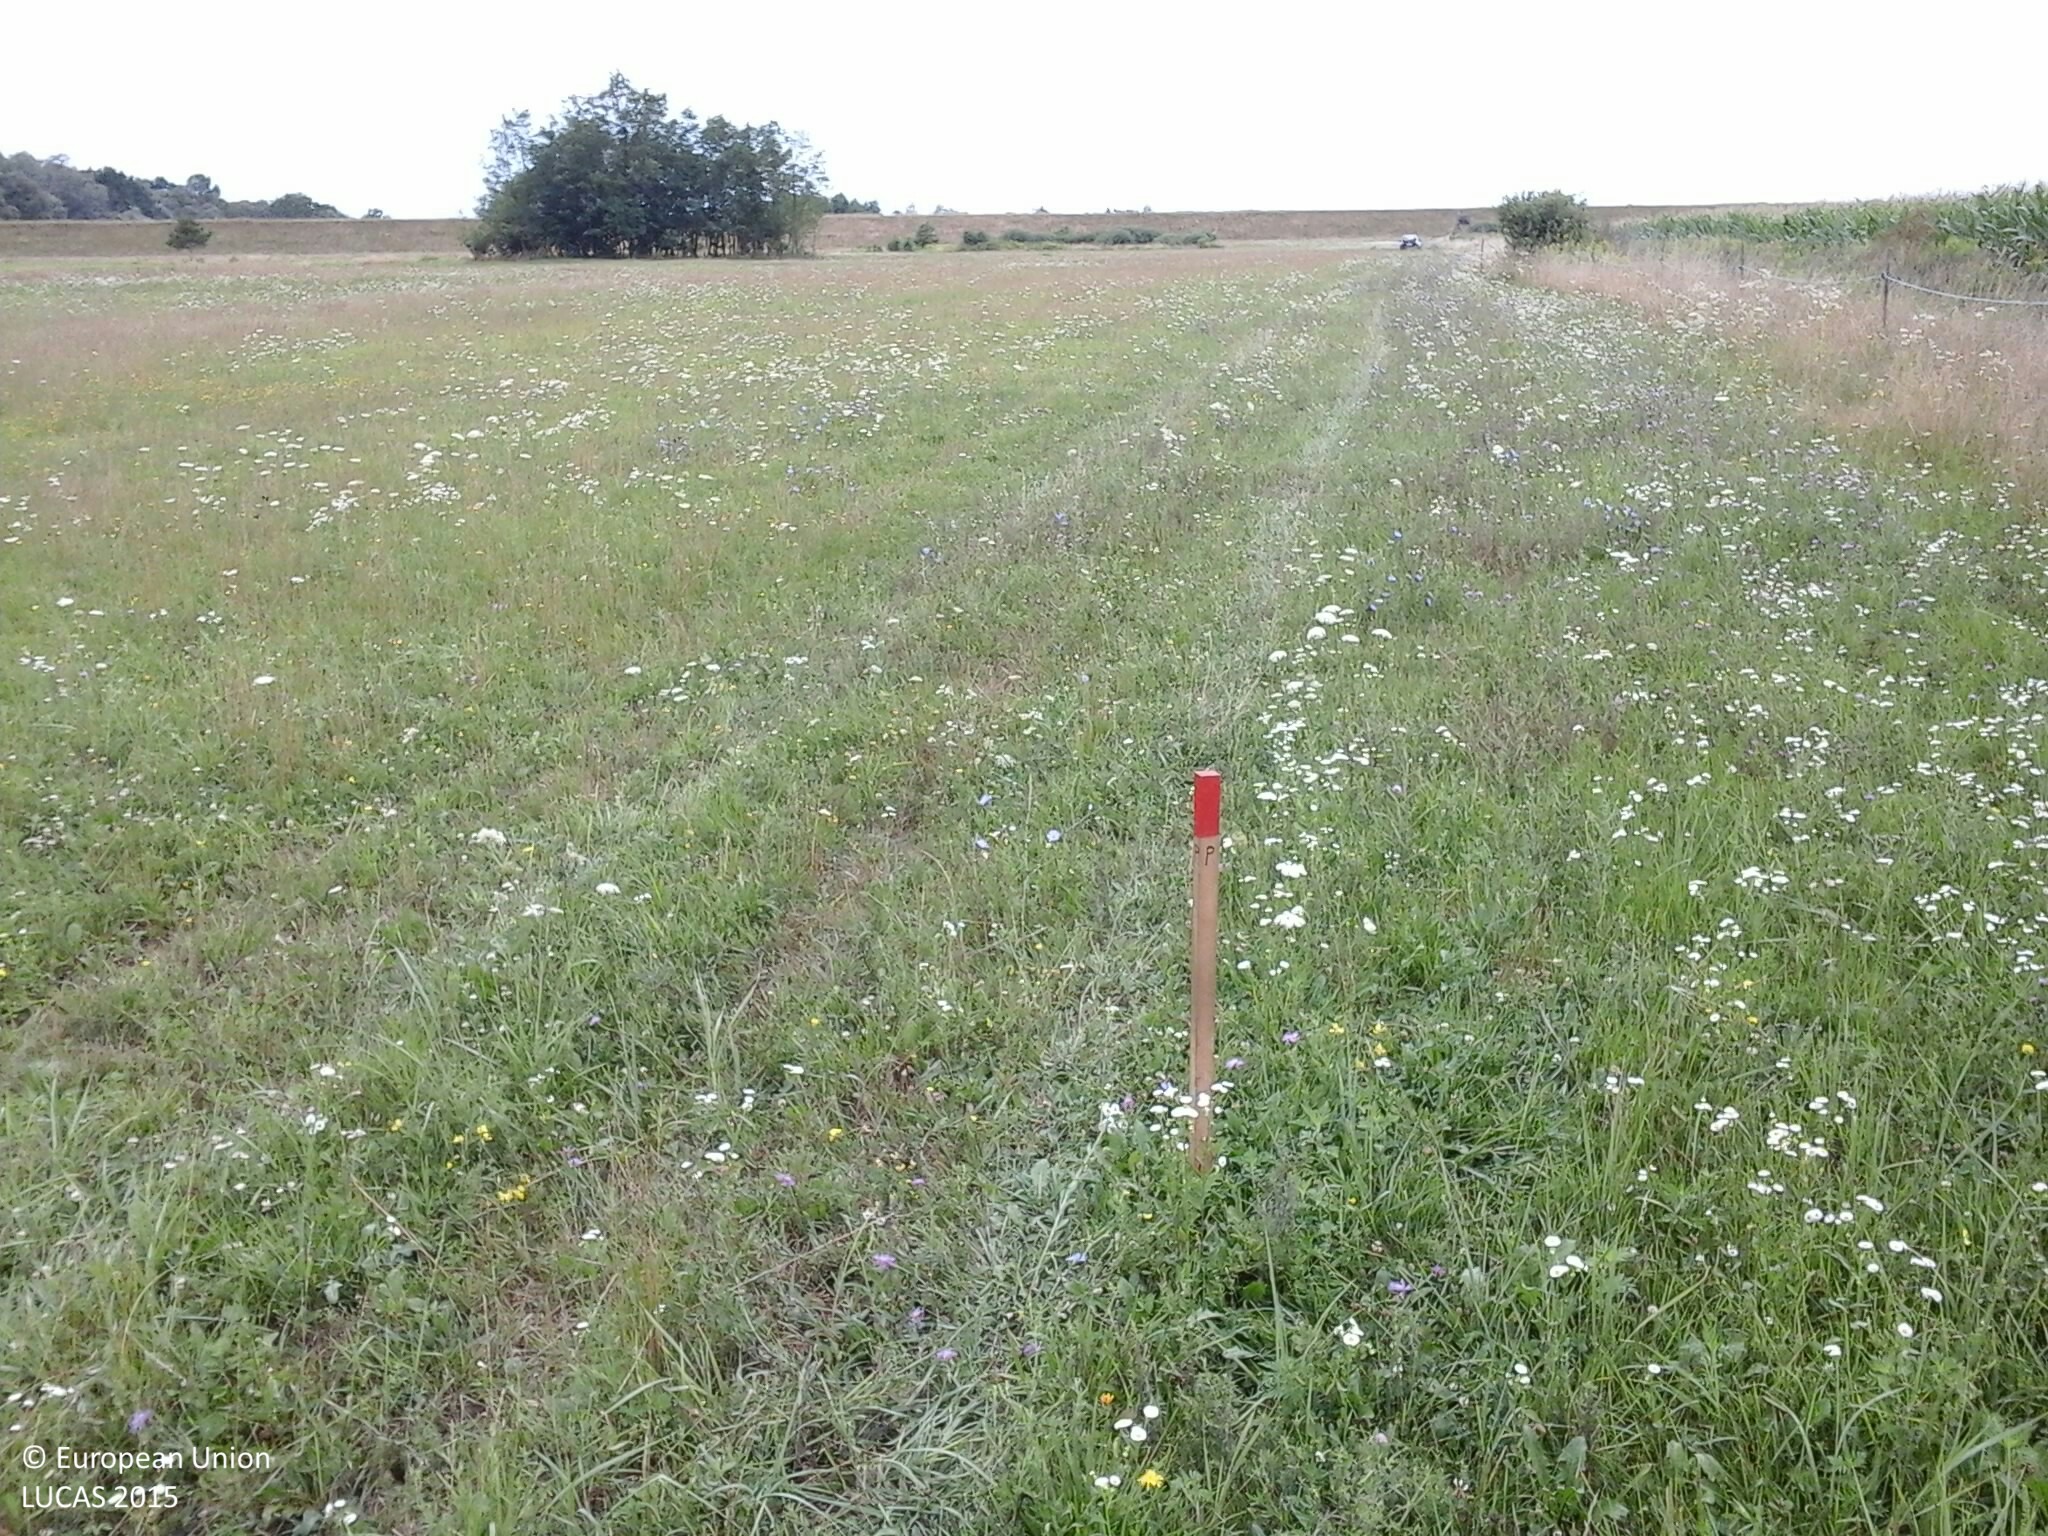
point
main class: Grassland
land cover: Grassland without tree/shrub cover
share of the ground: > 75 %
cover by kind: herbaceous plants 100 %
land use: Agriculture (excluding fallow land and kitchen gardens)
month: July
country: HU
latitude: 46.7507
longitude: 16.4816
